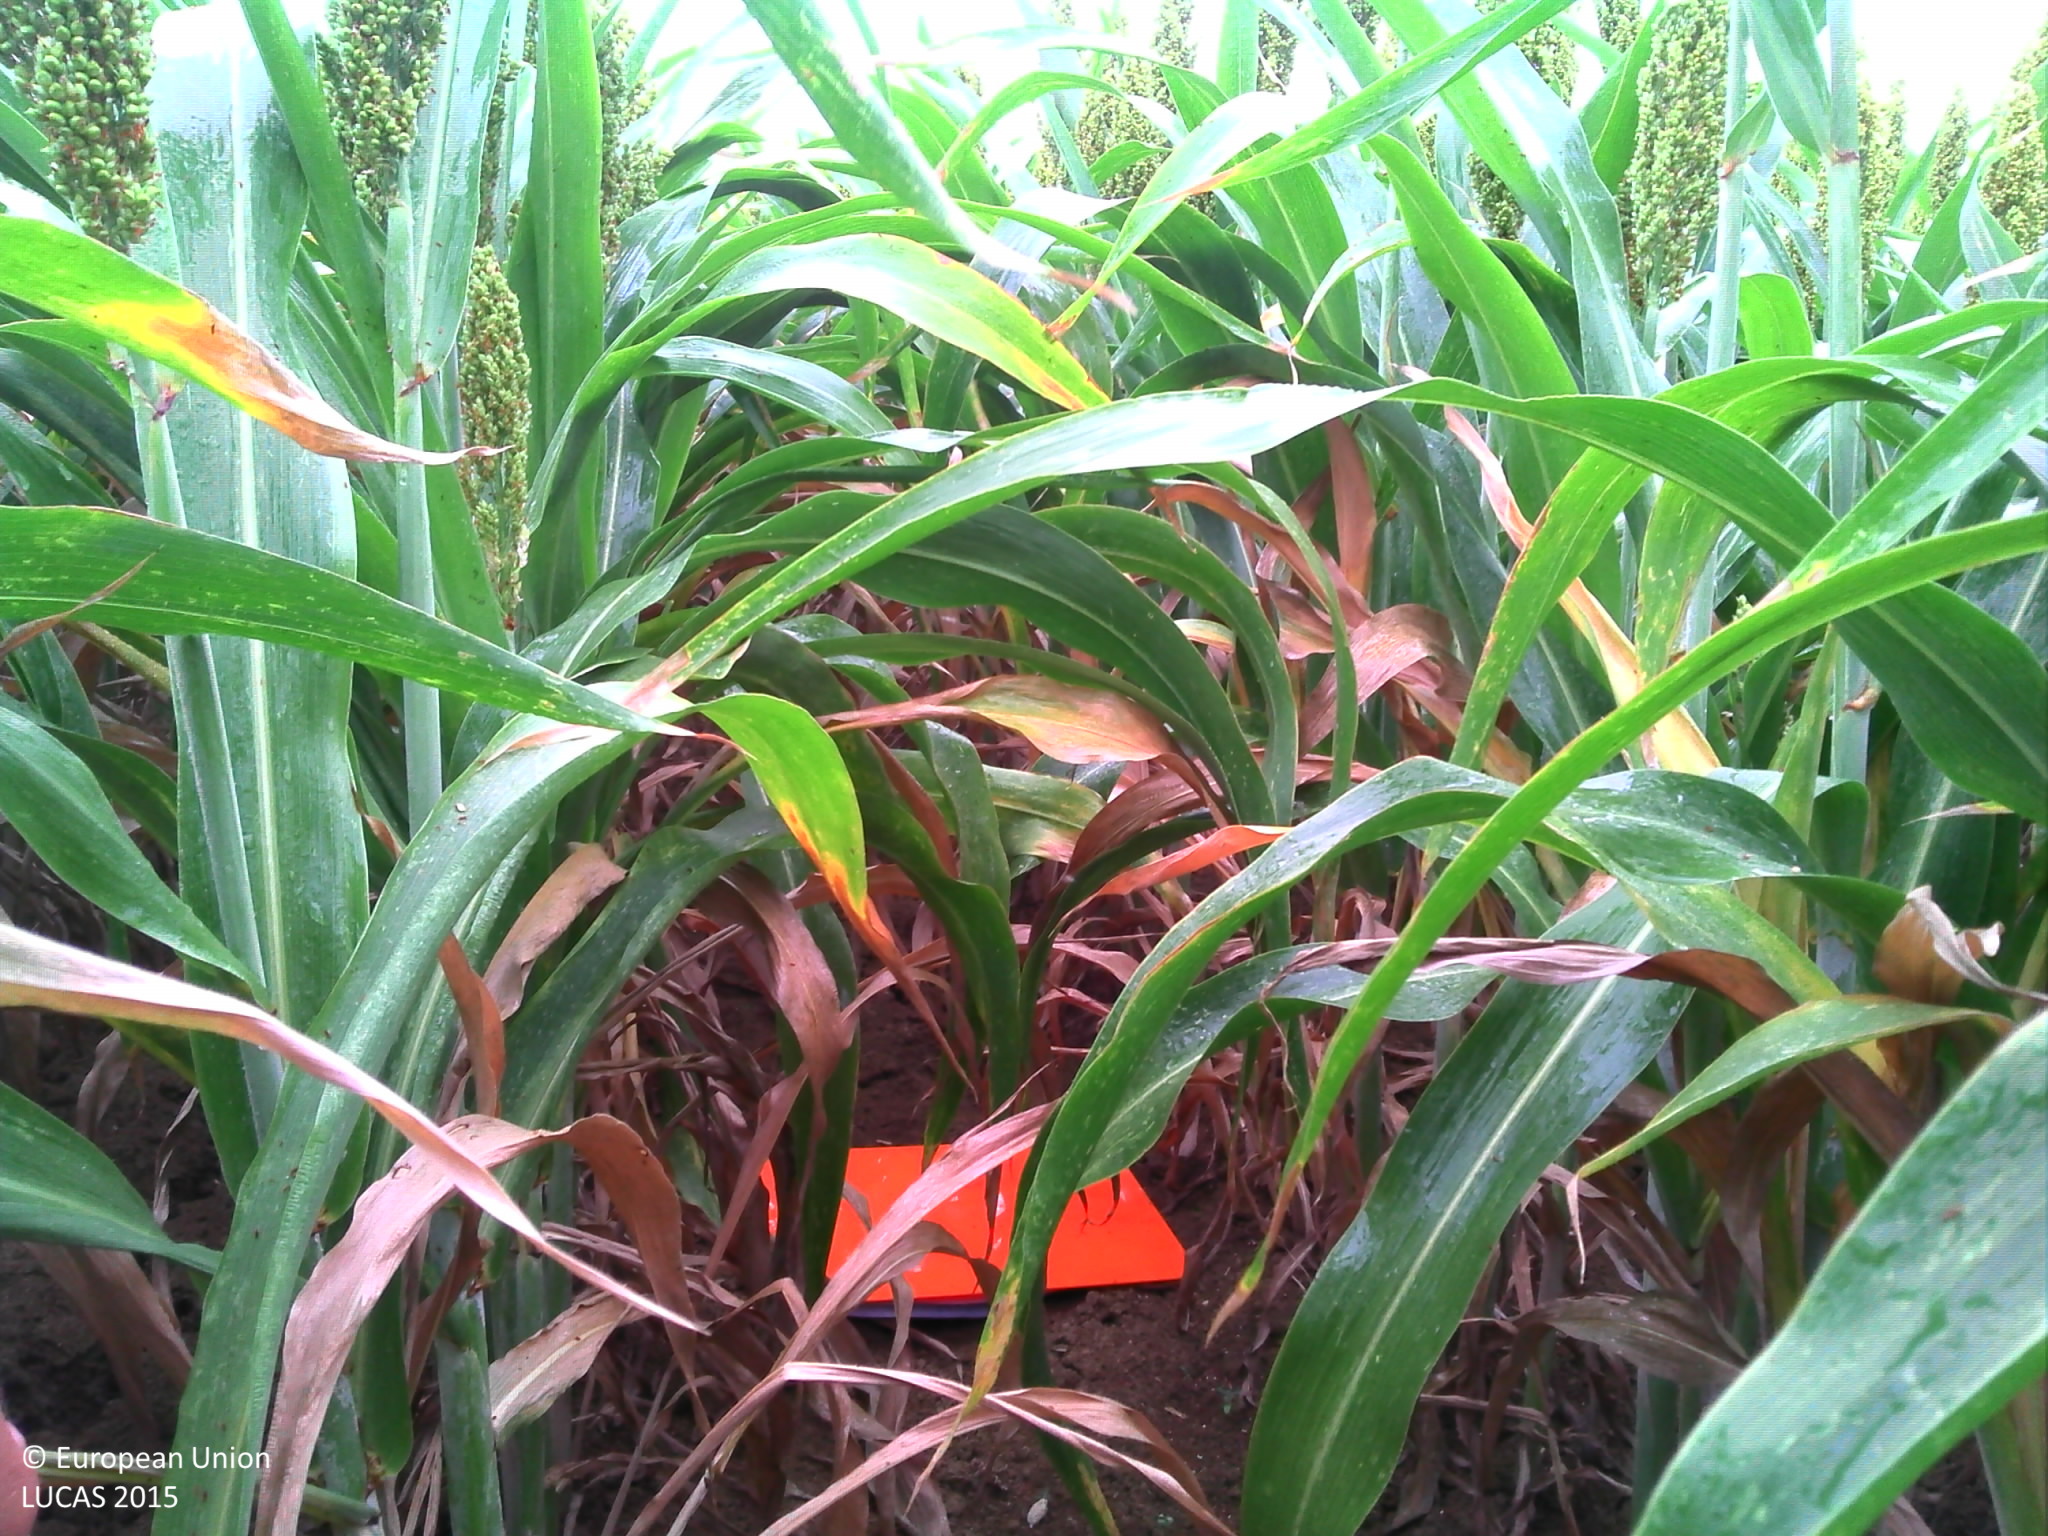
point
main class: Cropland
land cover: Other cereals
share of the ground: > 75 %
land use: Agriculture (excluding fallow land and kitchen gardens)
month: July
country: FR
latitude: 44.1816
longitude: 0.8521
